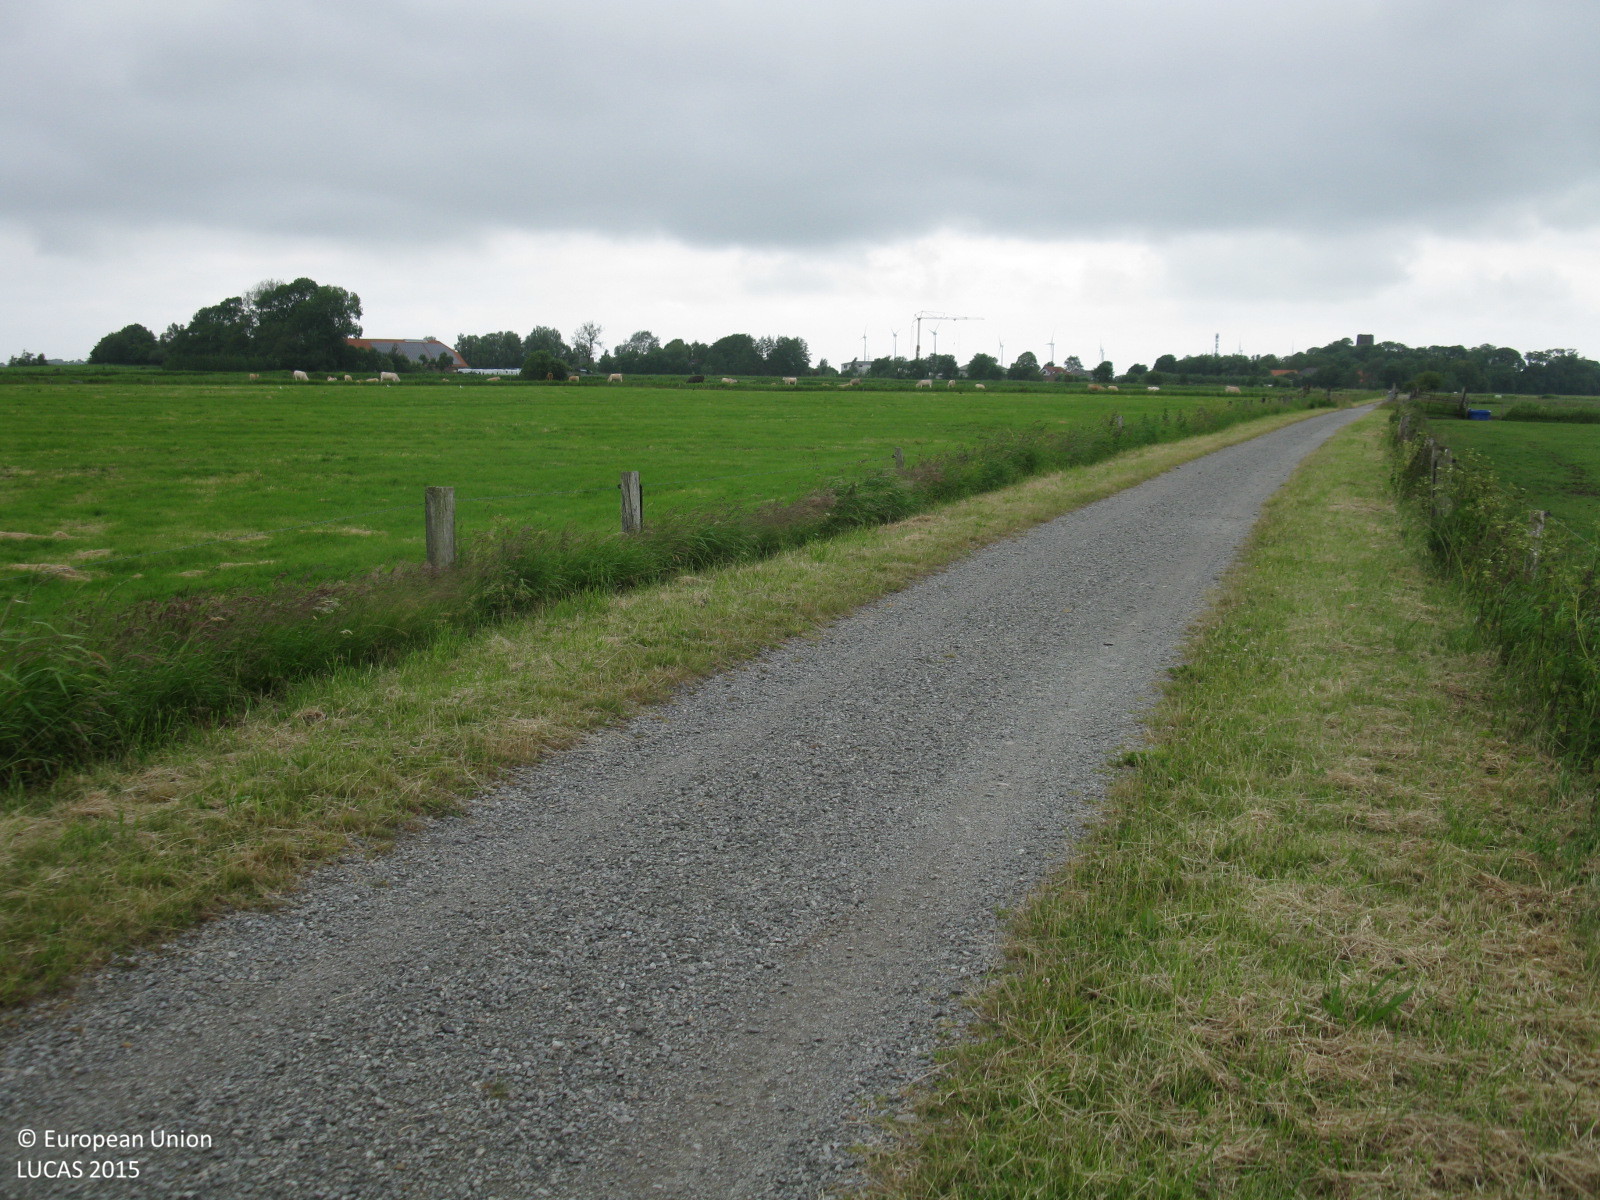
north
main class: Grassland
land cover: Grassland without tree/shrub cover
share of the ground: > 75 %
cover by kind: herbaceous plants 100 %
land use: Agriculture (excluding fallow land and kitchen gardens)
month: June
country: DE
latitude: 53.6534
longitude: 7.8977
